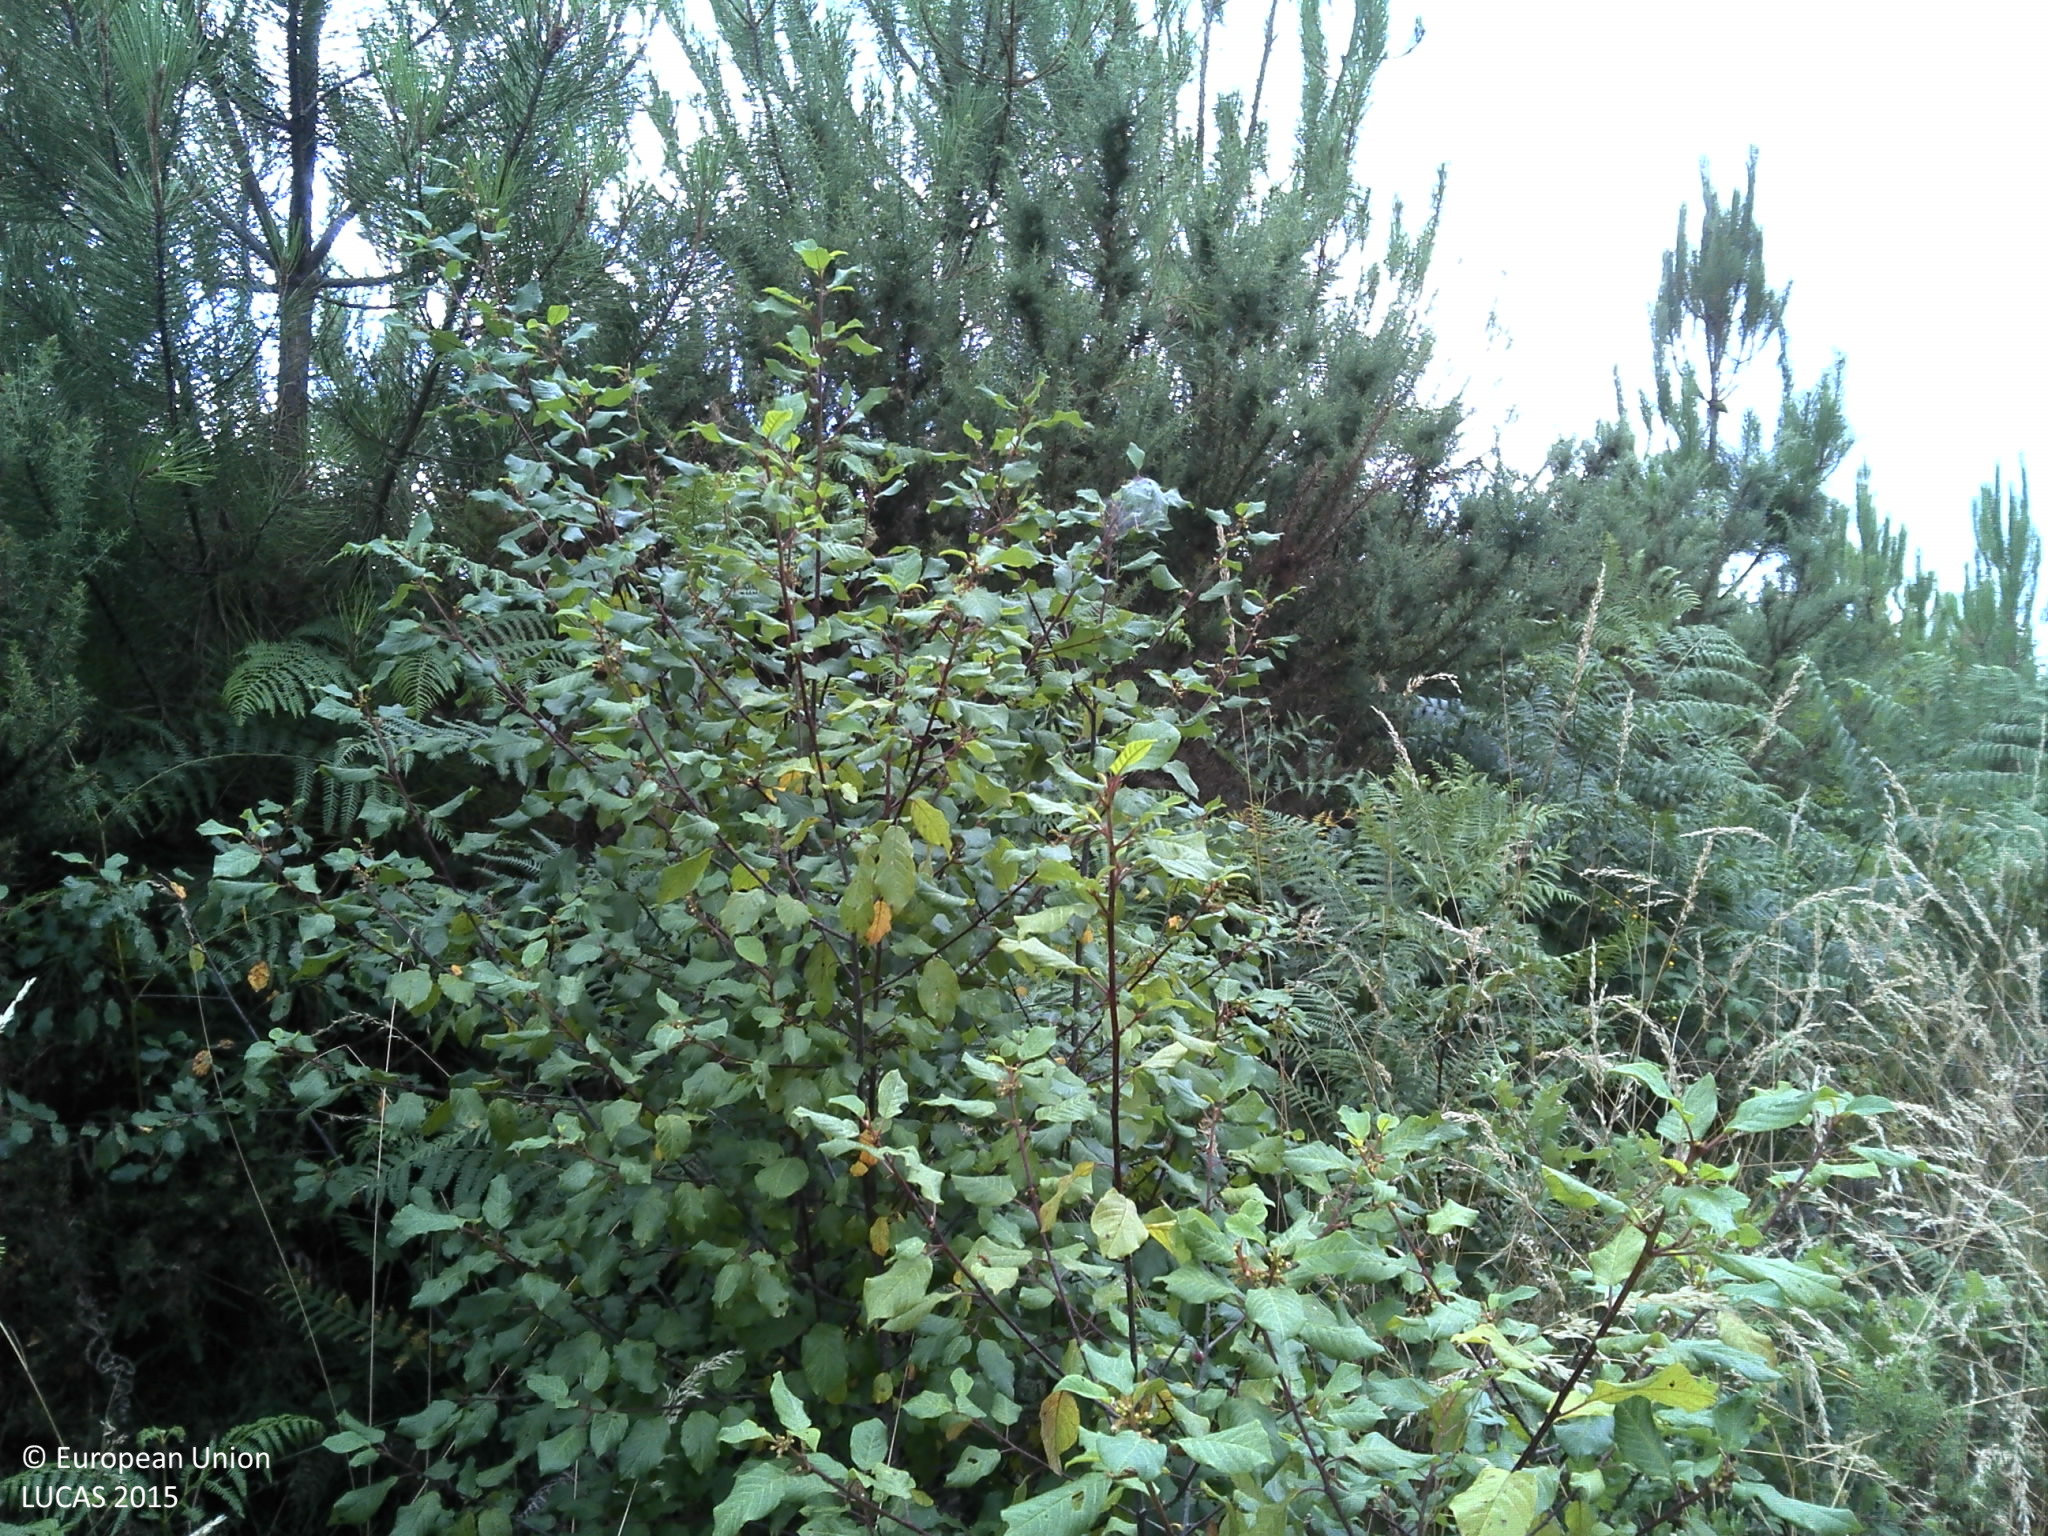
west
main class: Woodland
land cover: Pine dominated coniferous woodland
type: coniferous forest of the mediterranean region
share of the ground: > 75 %
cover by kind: coniferous forest trees 60 %, shrubs 35 %, herbaceous plants 5 %
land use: Forestry
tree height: < 5 m
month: July
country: FR
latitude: 44.9862
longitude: -0.7892
